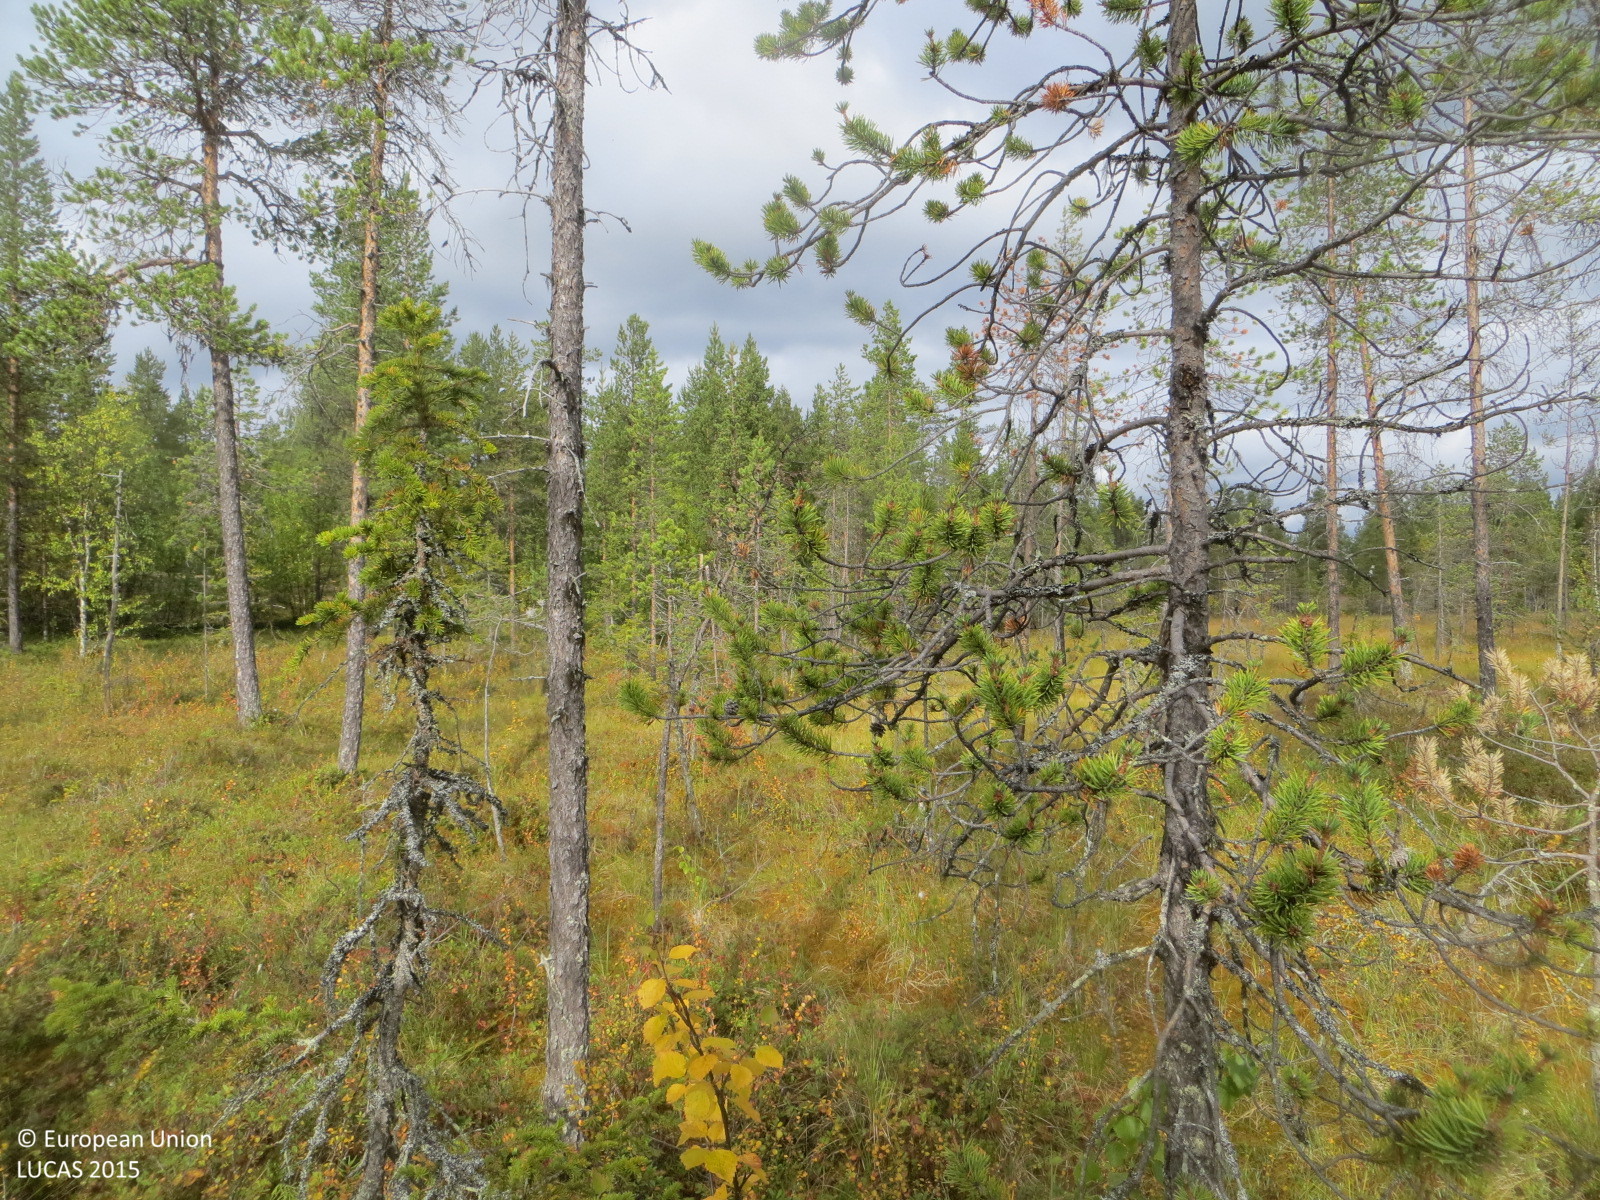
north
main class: Woodland
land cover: Pine dominated coniferous woodland
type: mire and swamp forests
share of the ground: 25 - 50 %
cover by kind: shrubs 60 %, coniferous forest trees 40 %
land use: Forestry
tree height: > 5 m
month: September
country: FI
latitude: 68.1276
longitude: 24.2328
